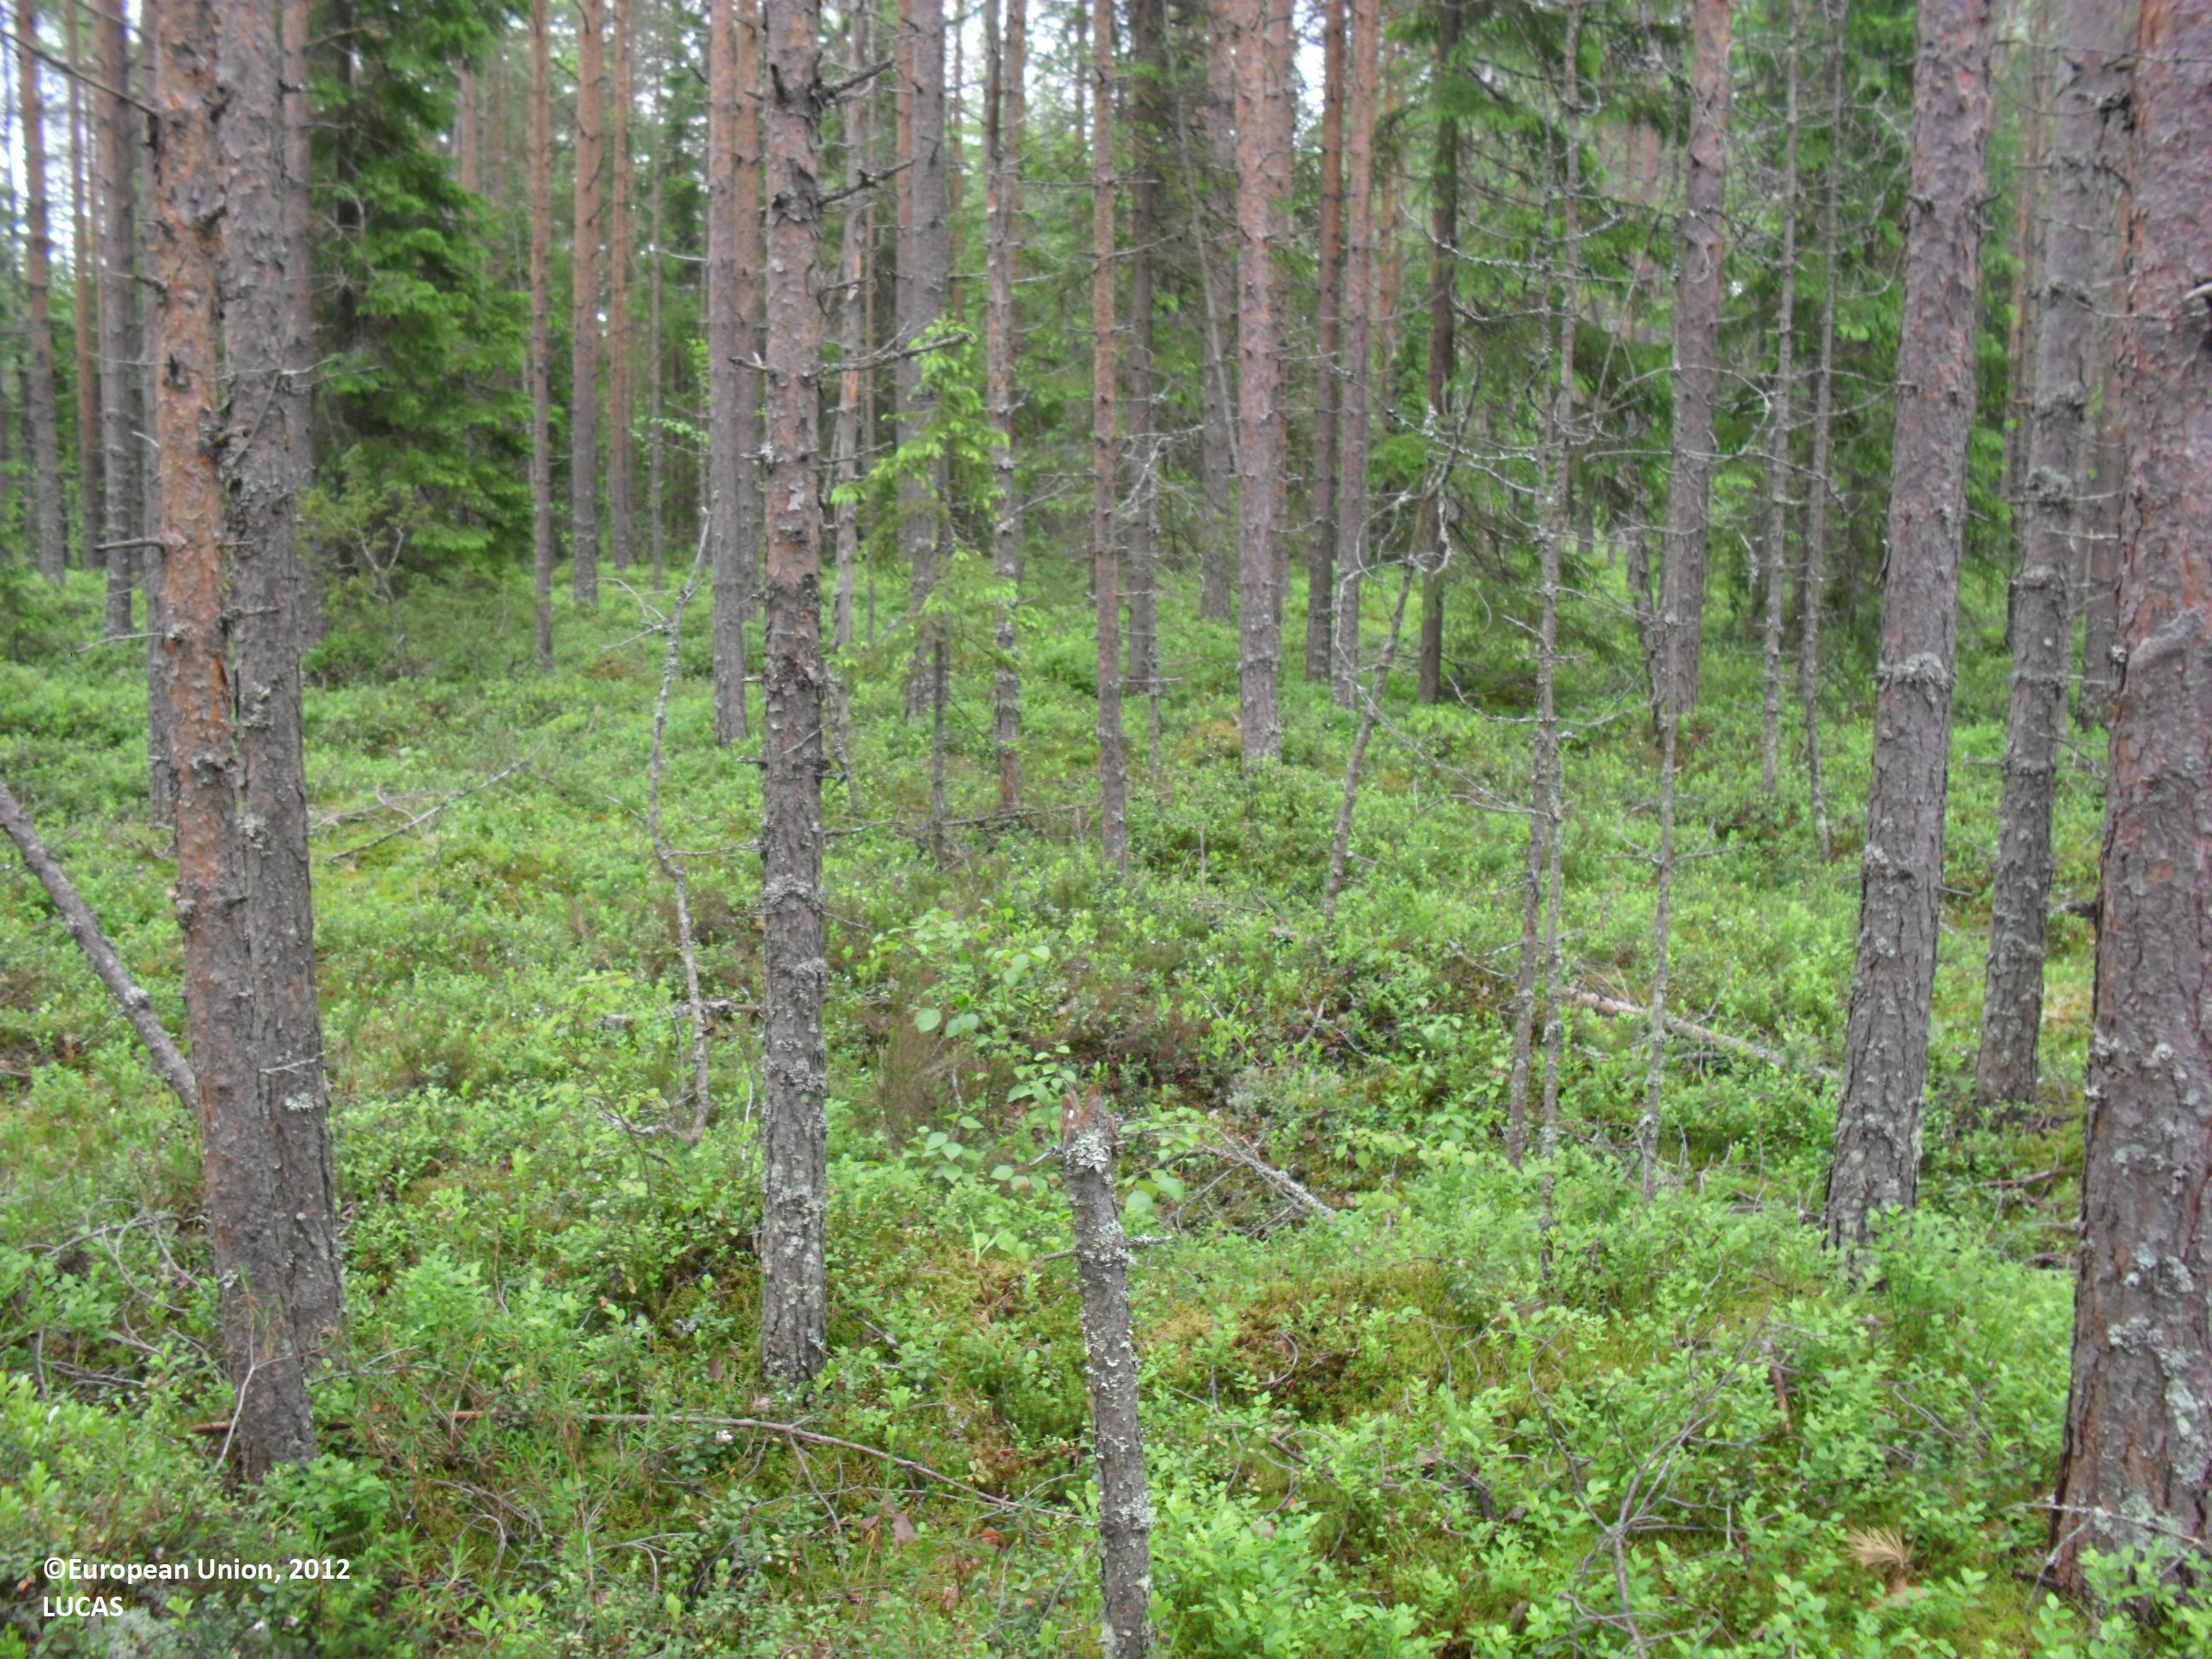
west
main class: Woodland
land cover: Pine dominated coniferous woodland
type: boreal forest
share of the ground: 50 - 75 %
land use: Forestry
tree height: > 5 m
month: June
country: FI
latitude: 63.1947
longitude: 23.2788
